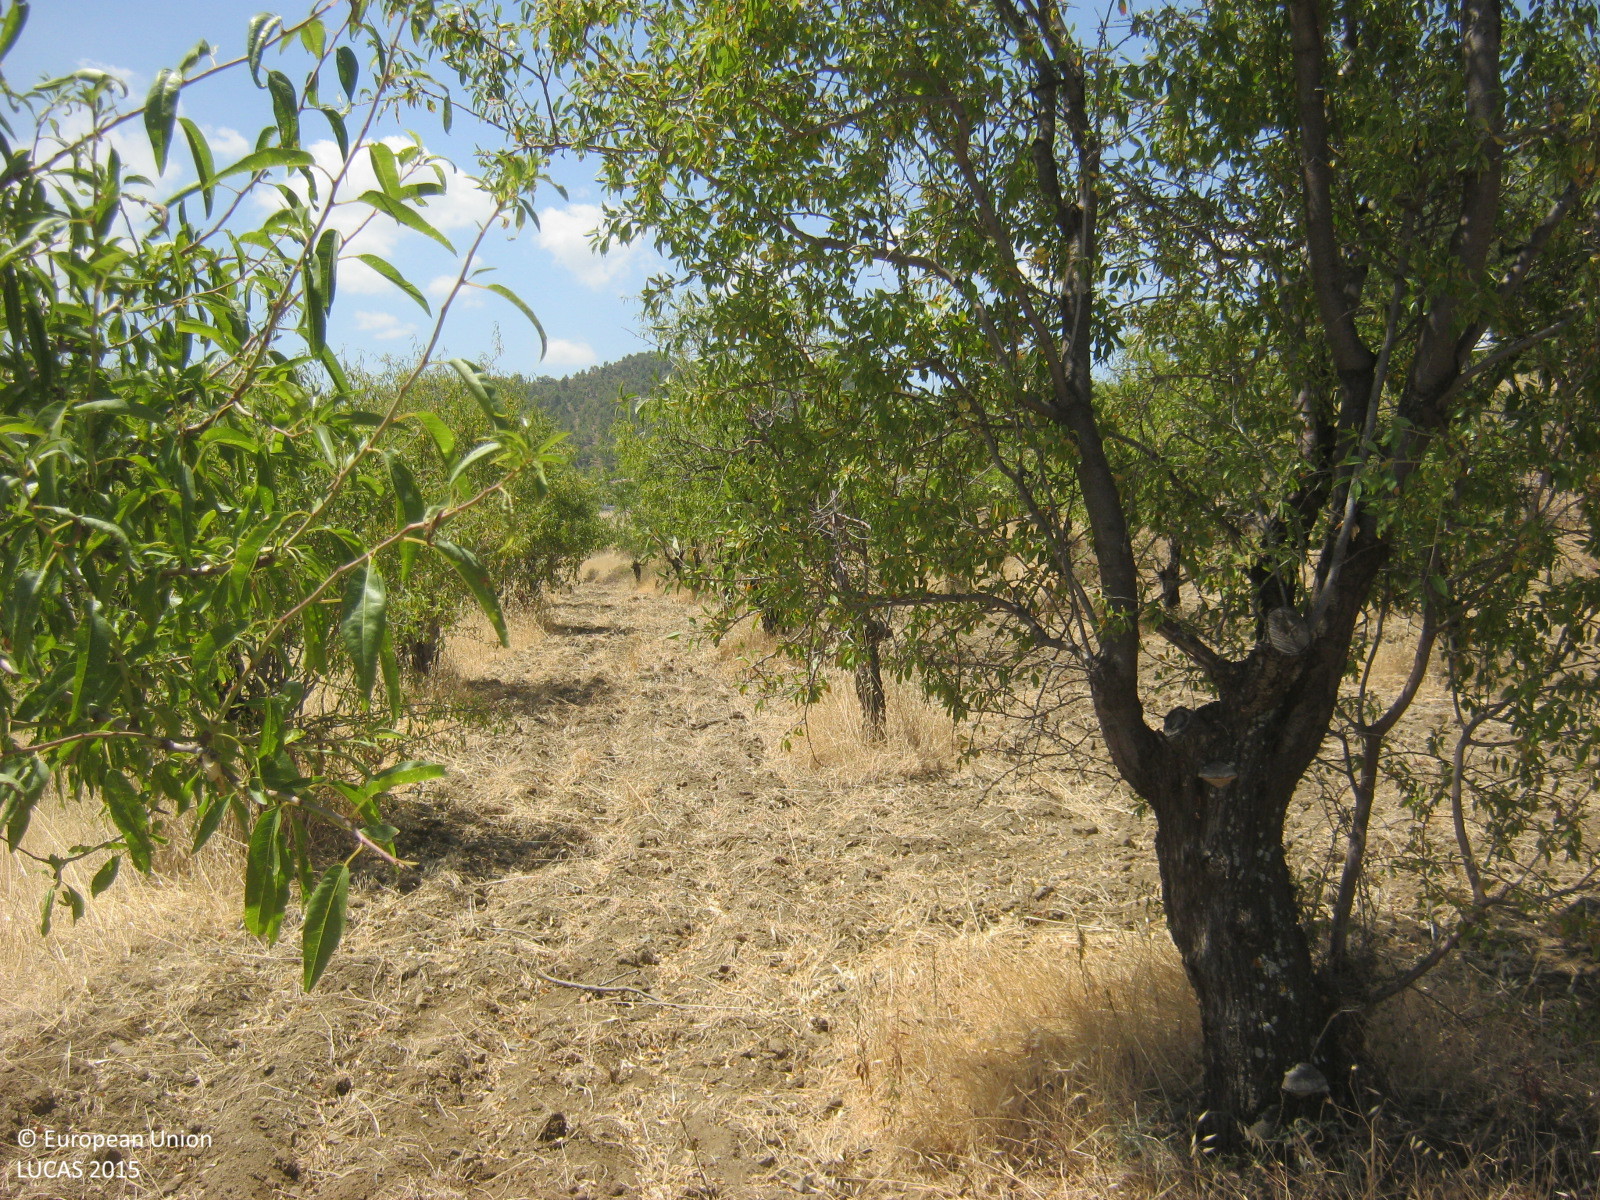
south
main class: Cropland
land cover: Nuts trees
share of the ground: 25 - 50 %
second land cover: Spontaneously vegetated surfaces
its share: 10 - 25 %
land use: Agriculture (excluding fallow land and kitchen gardens)
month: June
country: CY
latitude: 35.0152
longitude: 33.1613
